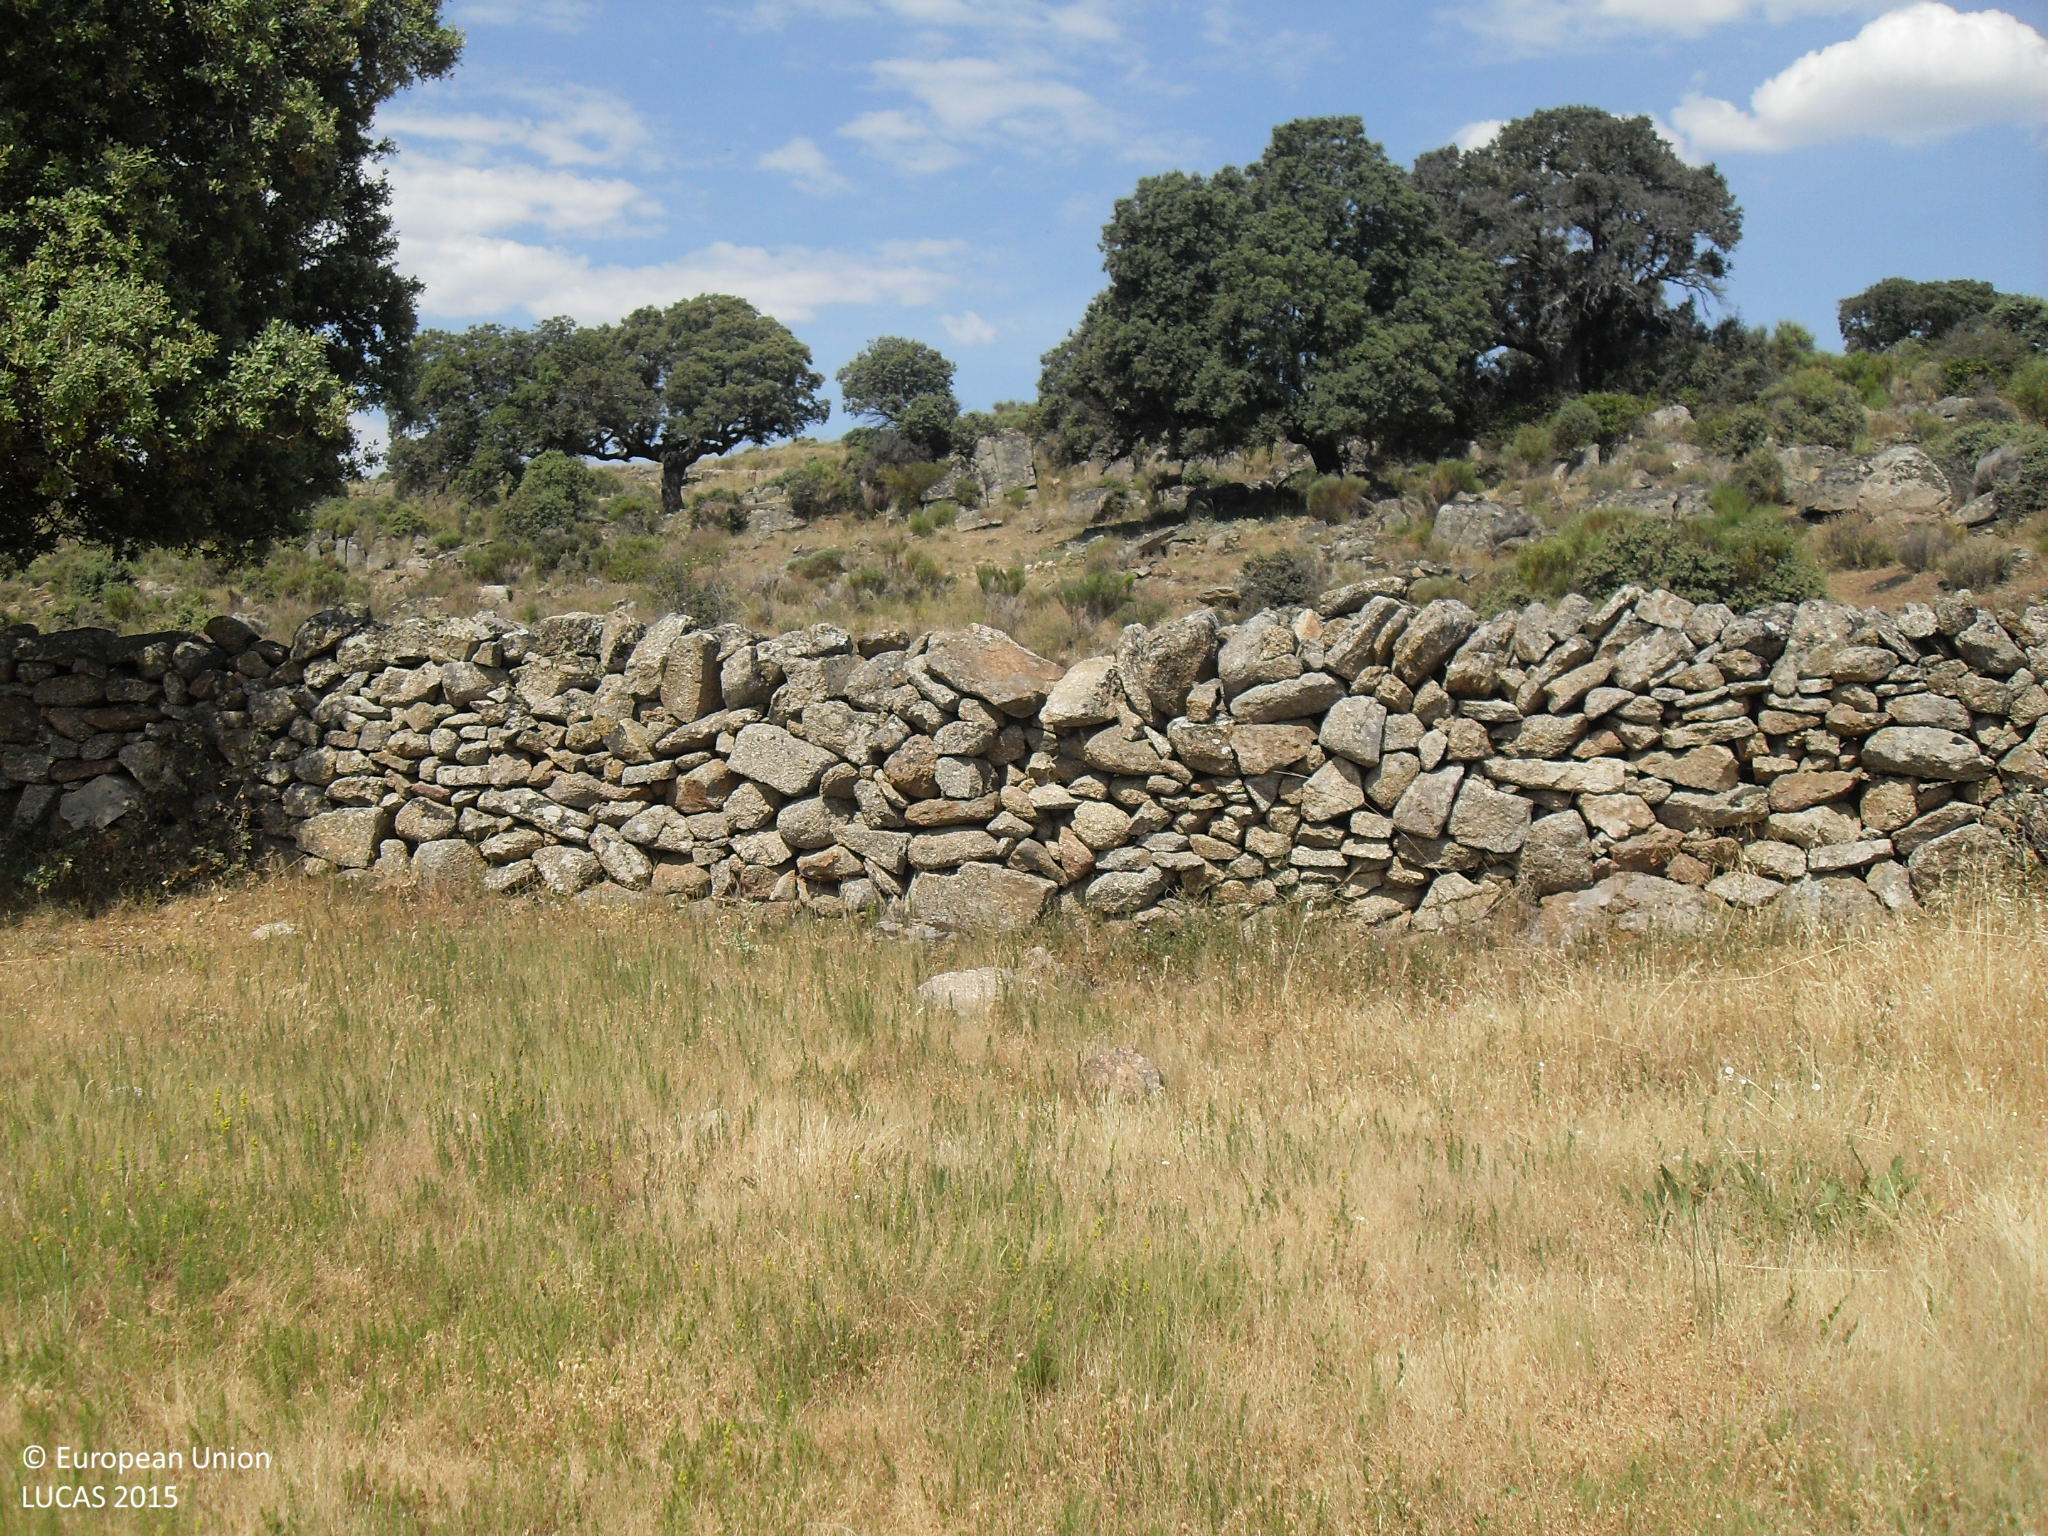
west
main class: Grassland
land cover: Grassland with sparse tree/shrub cover
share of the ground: > 75 %
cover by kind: herbaceous plants 95 %, broadleaved forest trees 5 %
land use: Agriculture (excluding fallow land and kitchen gardens)
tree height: < 5 m
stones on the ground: < 10 %
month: June
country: ES
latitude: 40.4704
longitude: -5.5542
